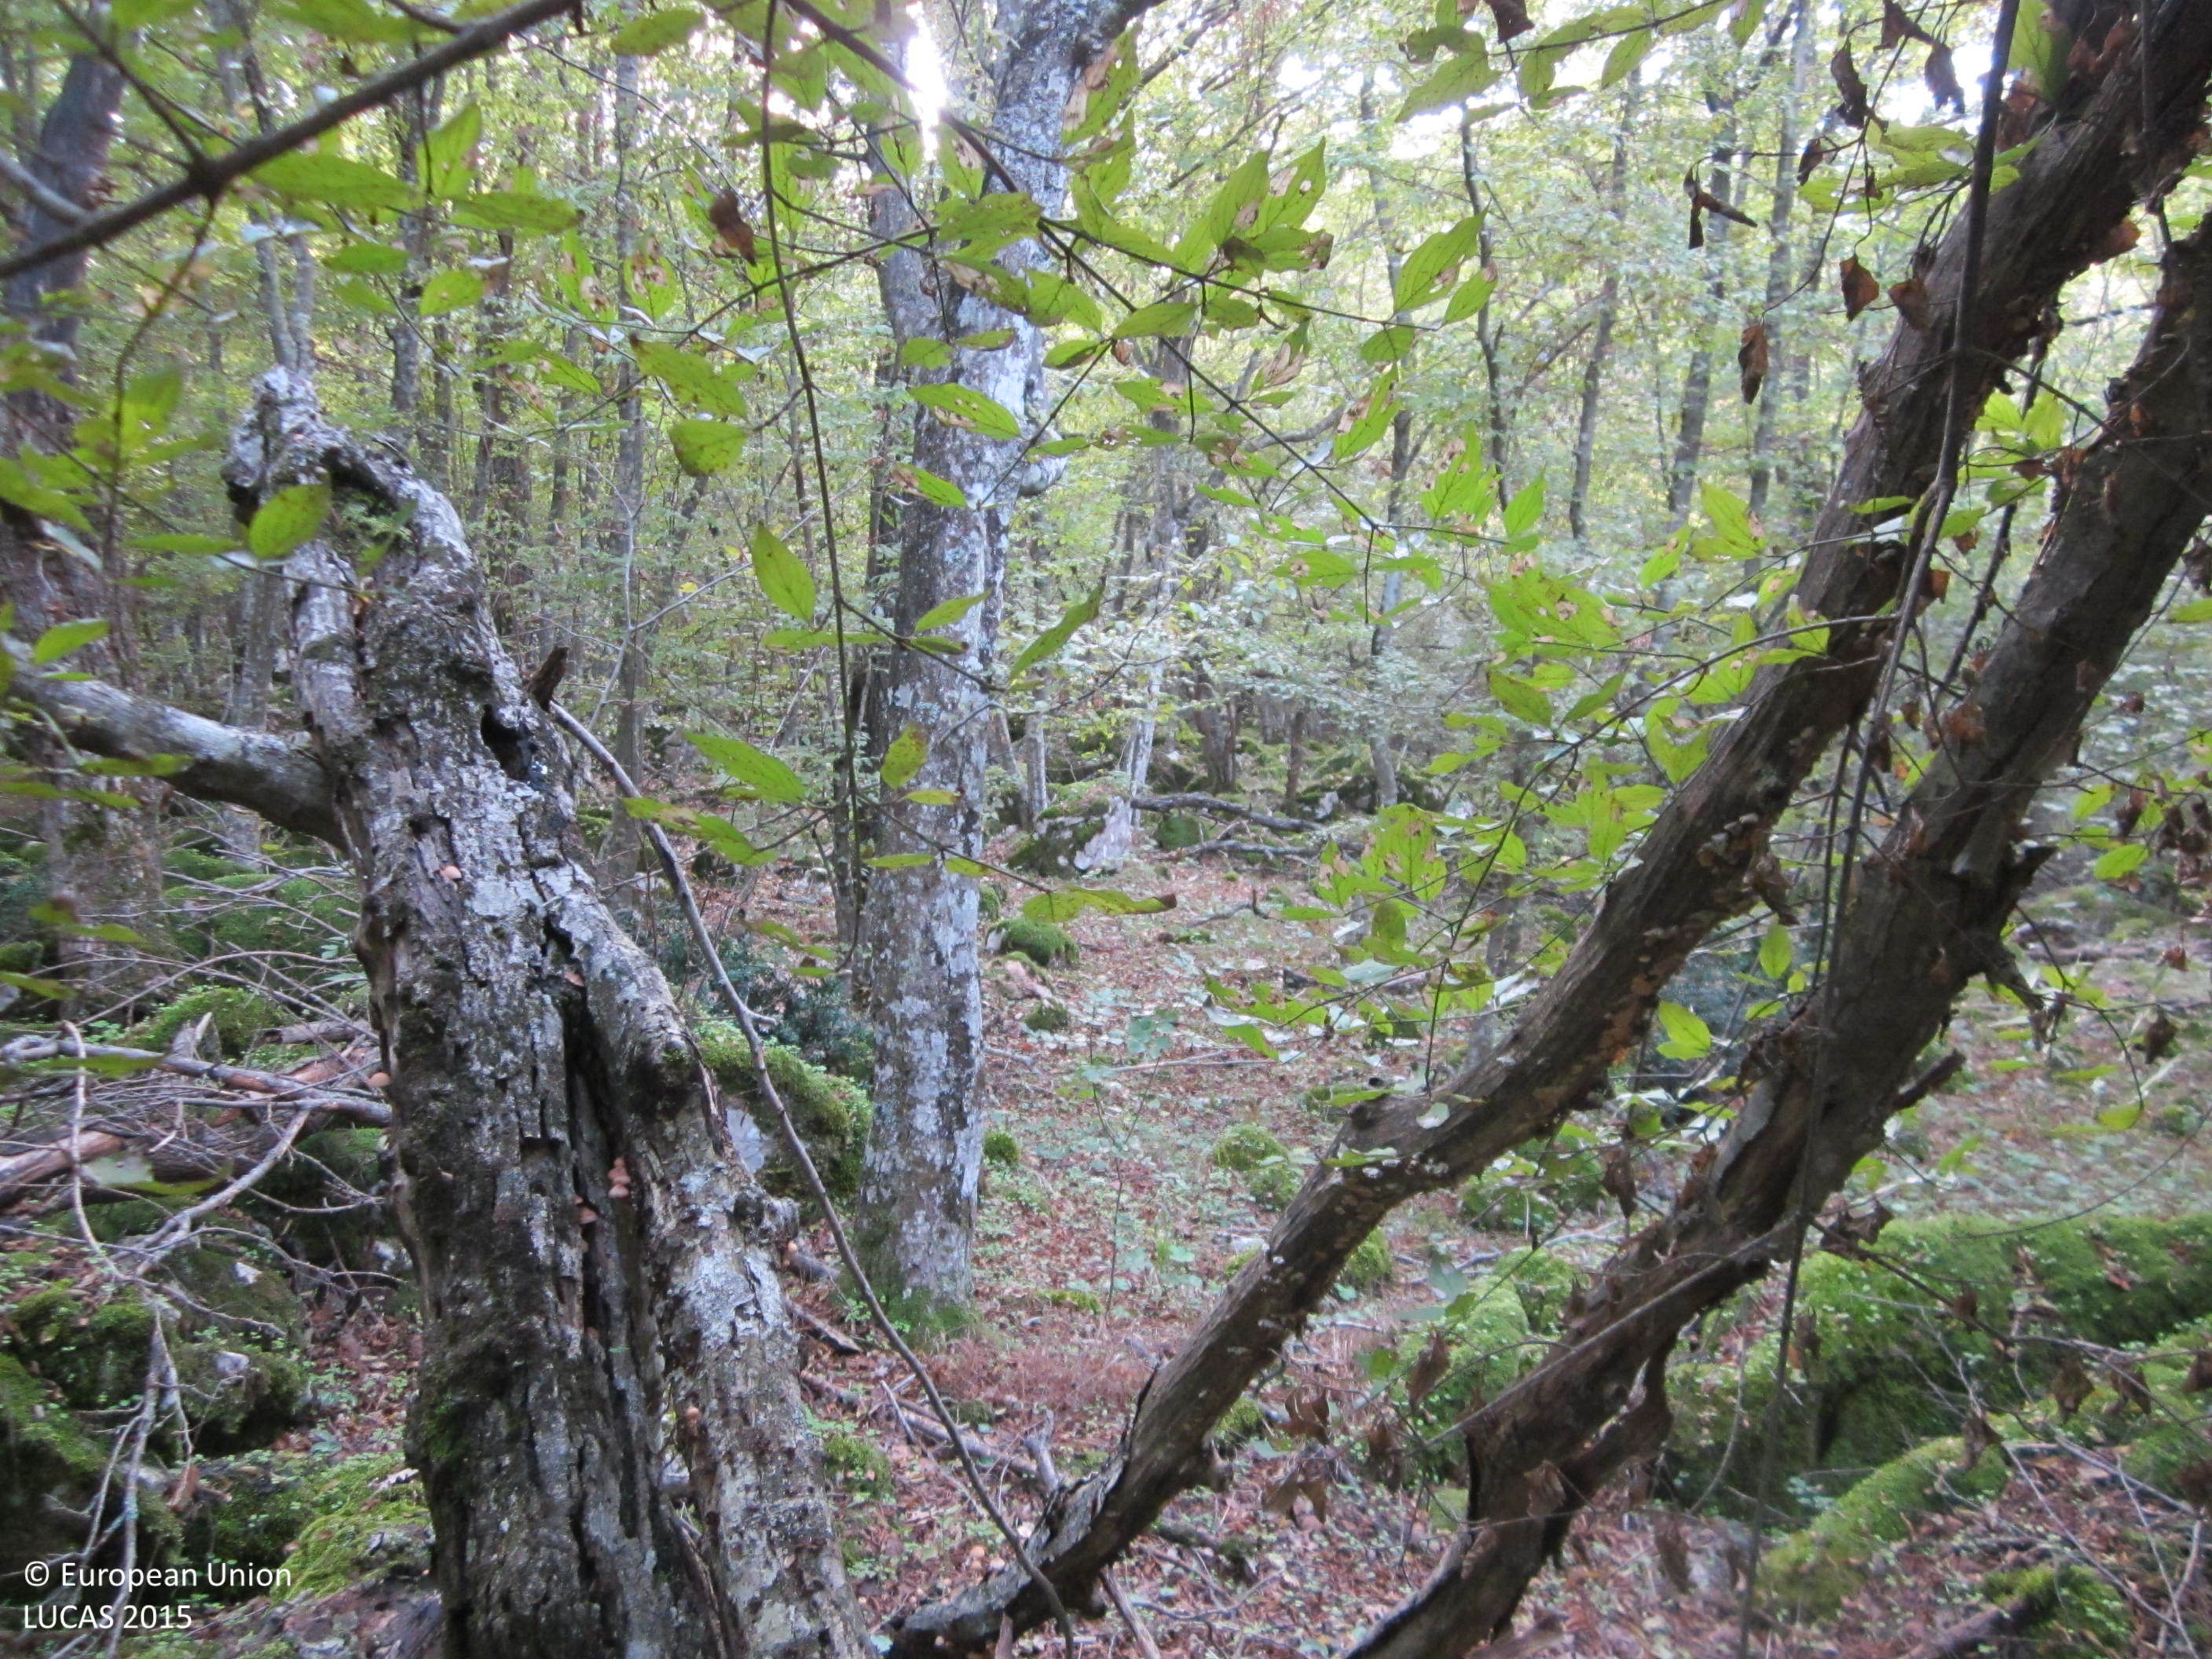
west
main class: Woodland
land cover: Broadleaved woodland
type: mesophytic deciduous forest
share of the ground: > 75 %
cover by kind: broadleaved forest trees 90 %, lichens and mosses 5 %, unconsolidated bare surface 5 %
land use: Forestry
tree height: > 5 m
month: October
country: BG
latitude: 42.2116
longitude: 27.2469
